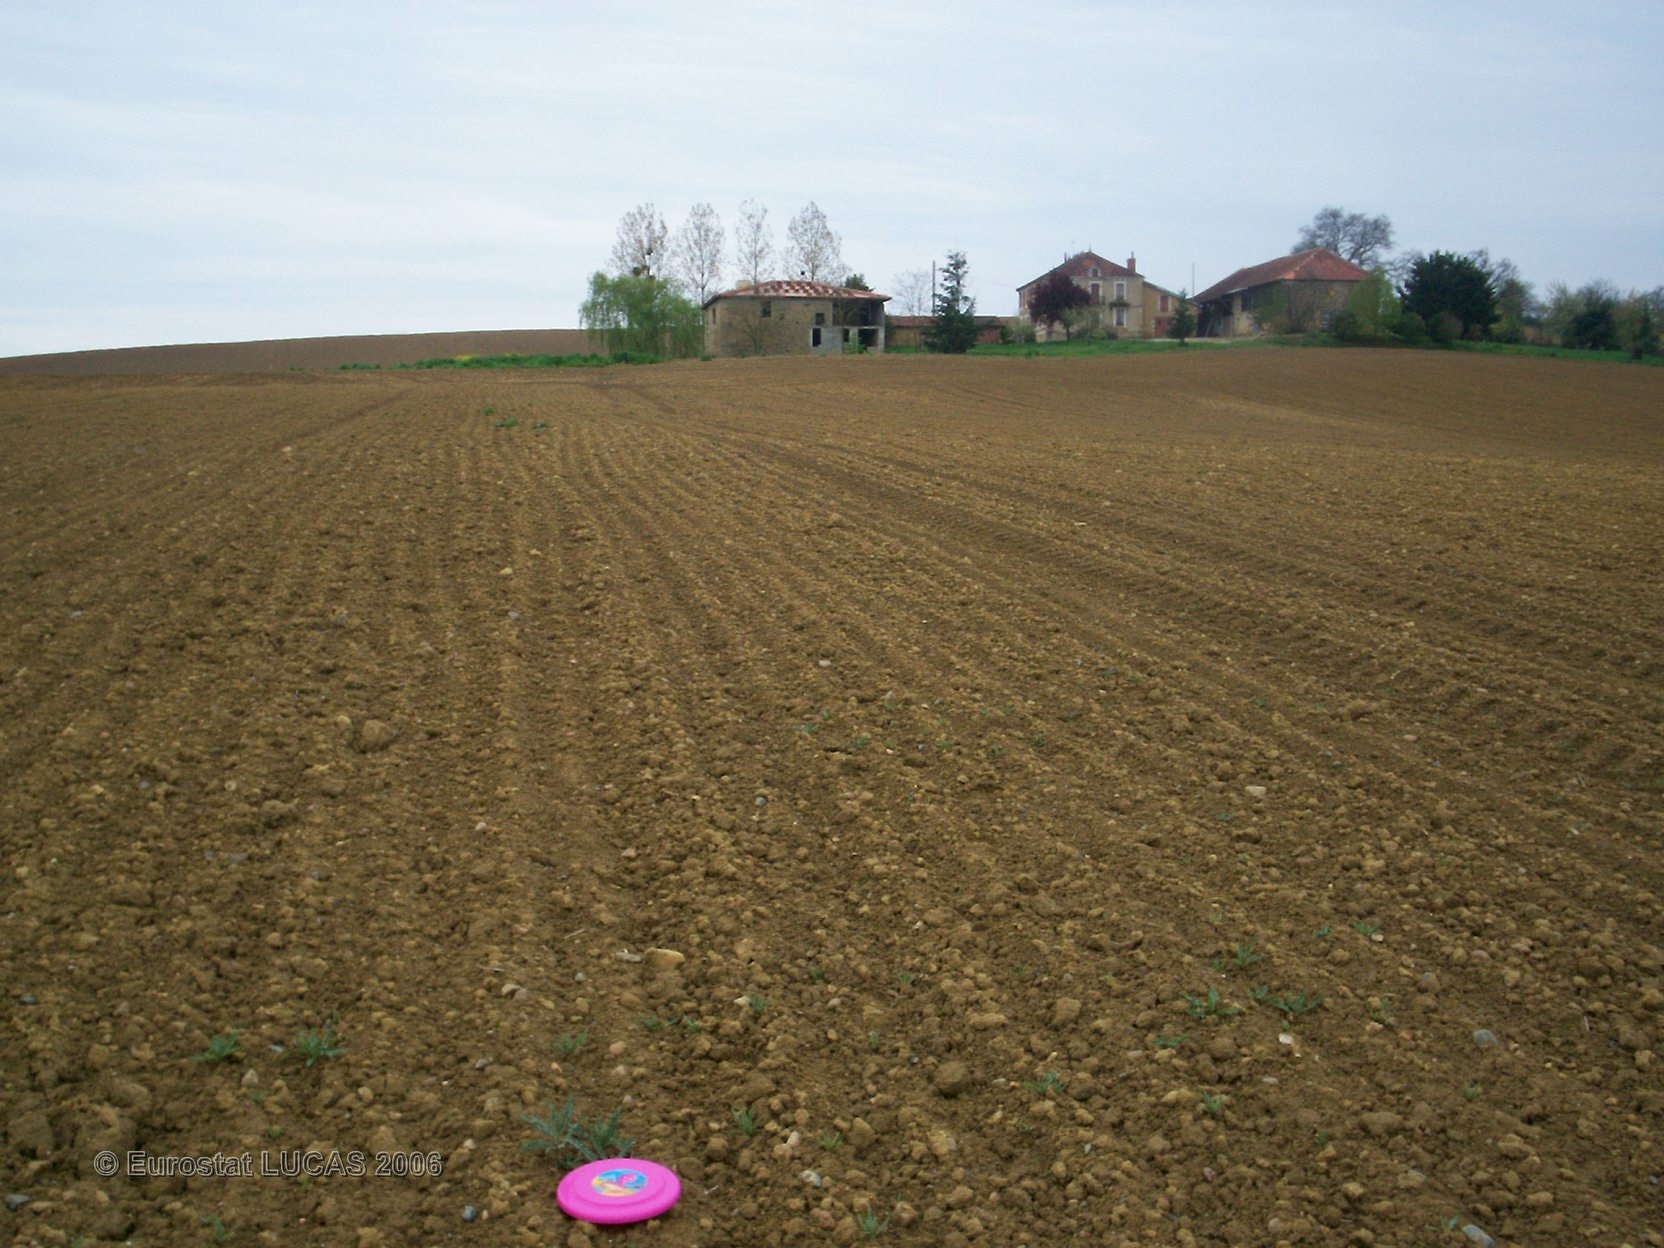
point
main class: Cropland
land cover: Maize
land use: Agriculture (excluding fallow land and kitchen gardens)
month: June
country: FR
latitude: 43.5684
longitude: 0.3016
